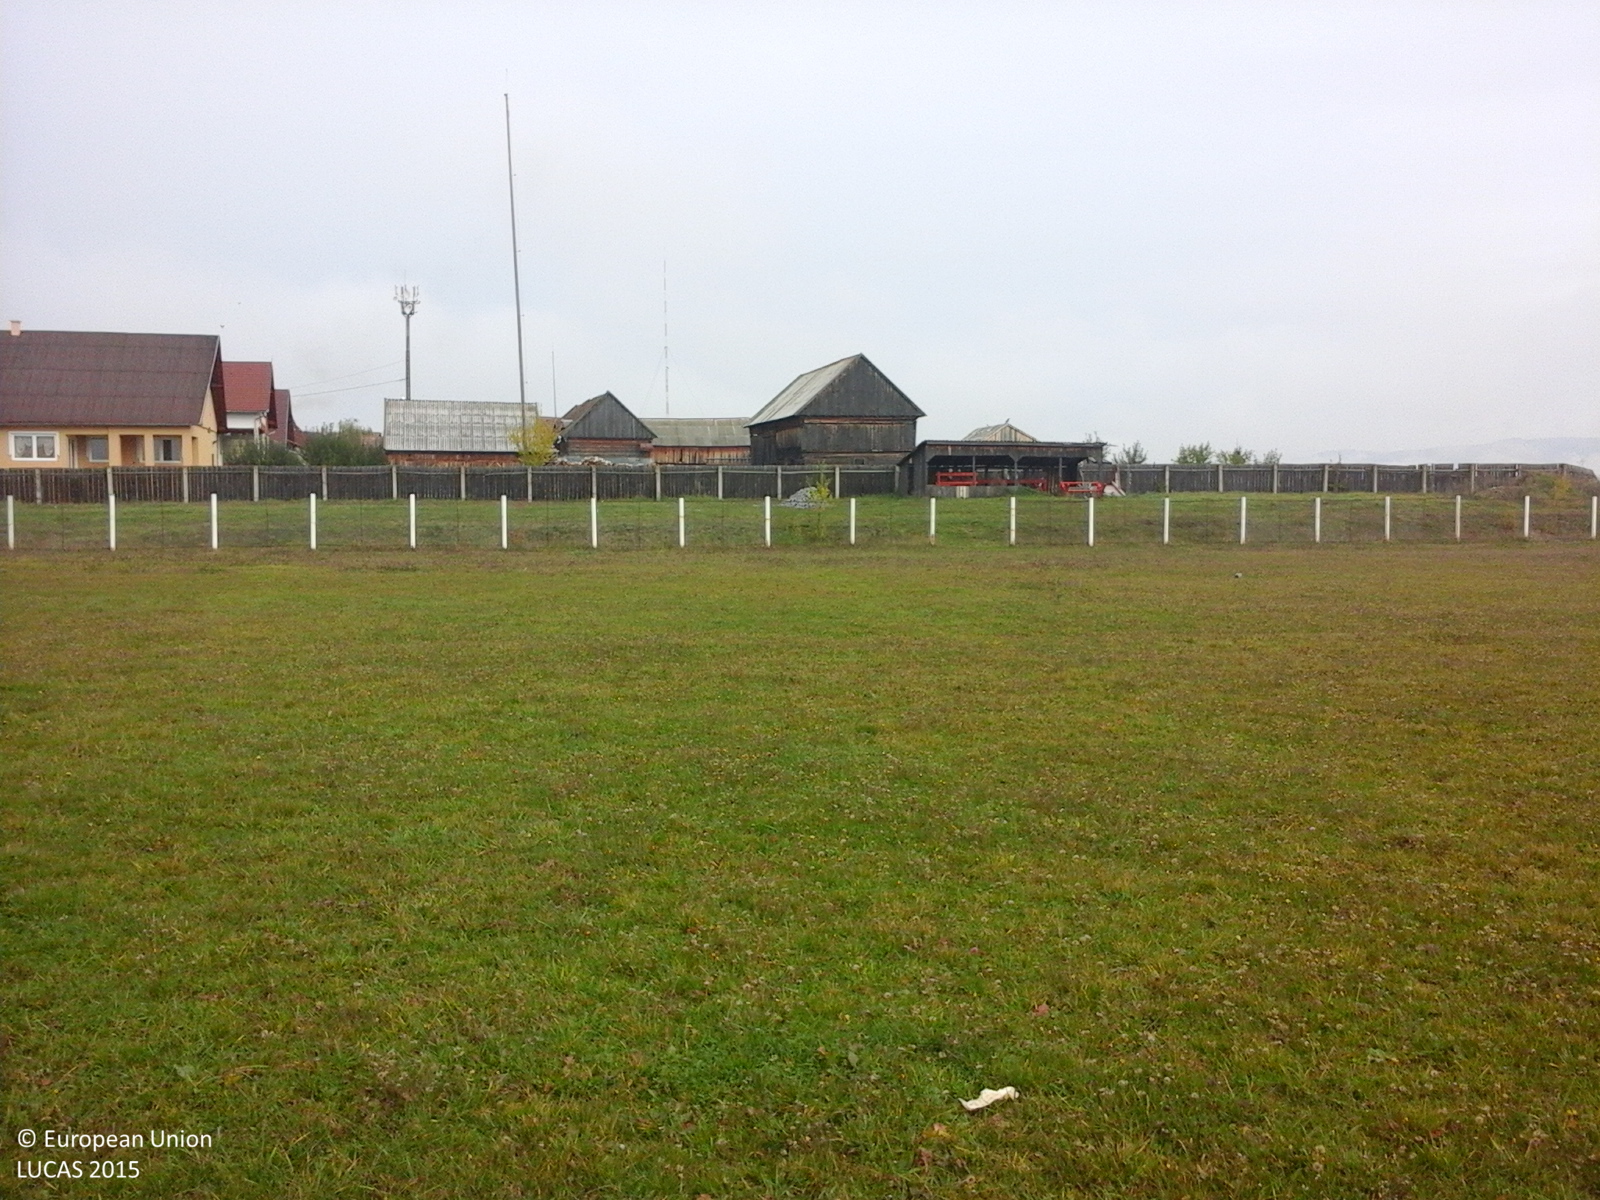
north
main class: Grassland
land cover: Grassland without tree/shrub cover
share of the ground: > 75 %
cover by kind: herbaceous plants 100 %
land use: Agriculture (excluding fallow land and kitchen gardens)
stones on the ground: < 10 %
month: October
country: RO
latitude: 46.7957
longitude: 25.4516
